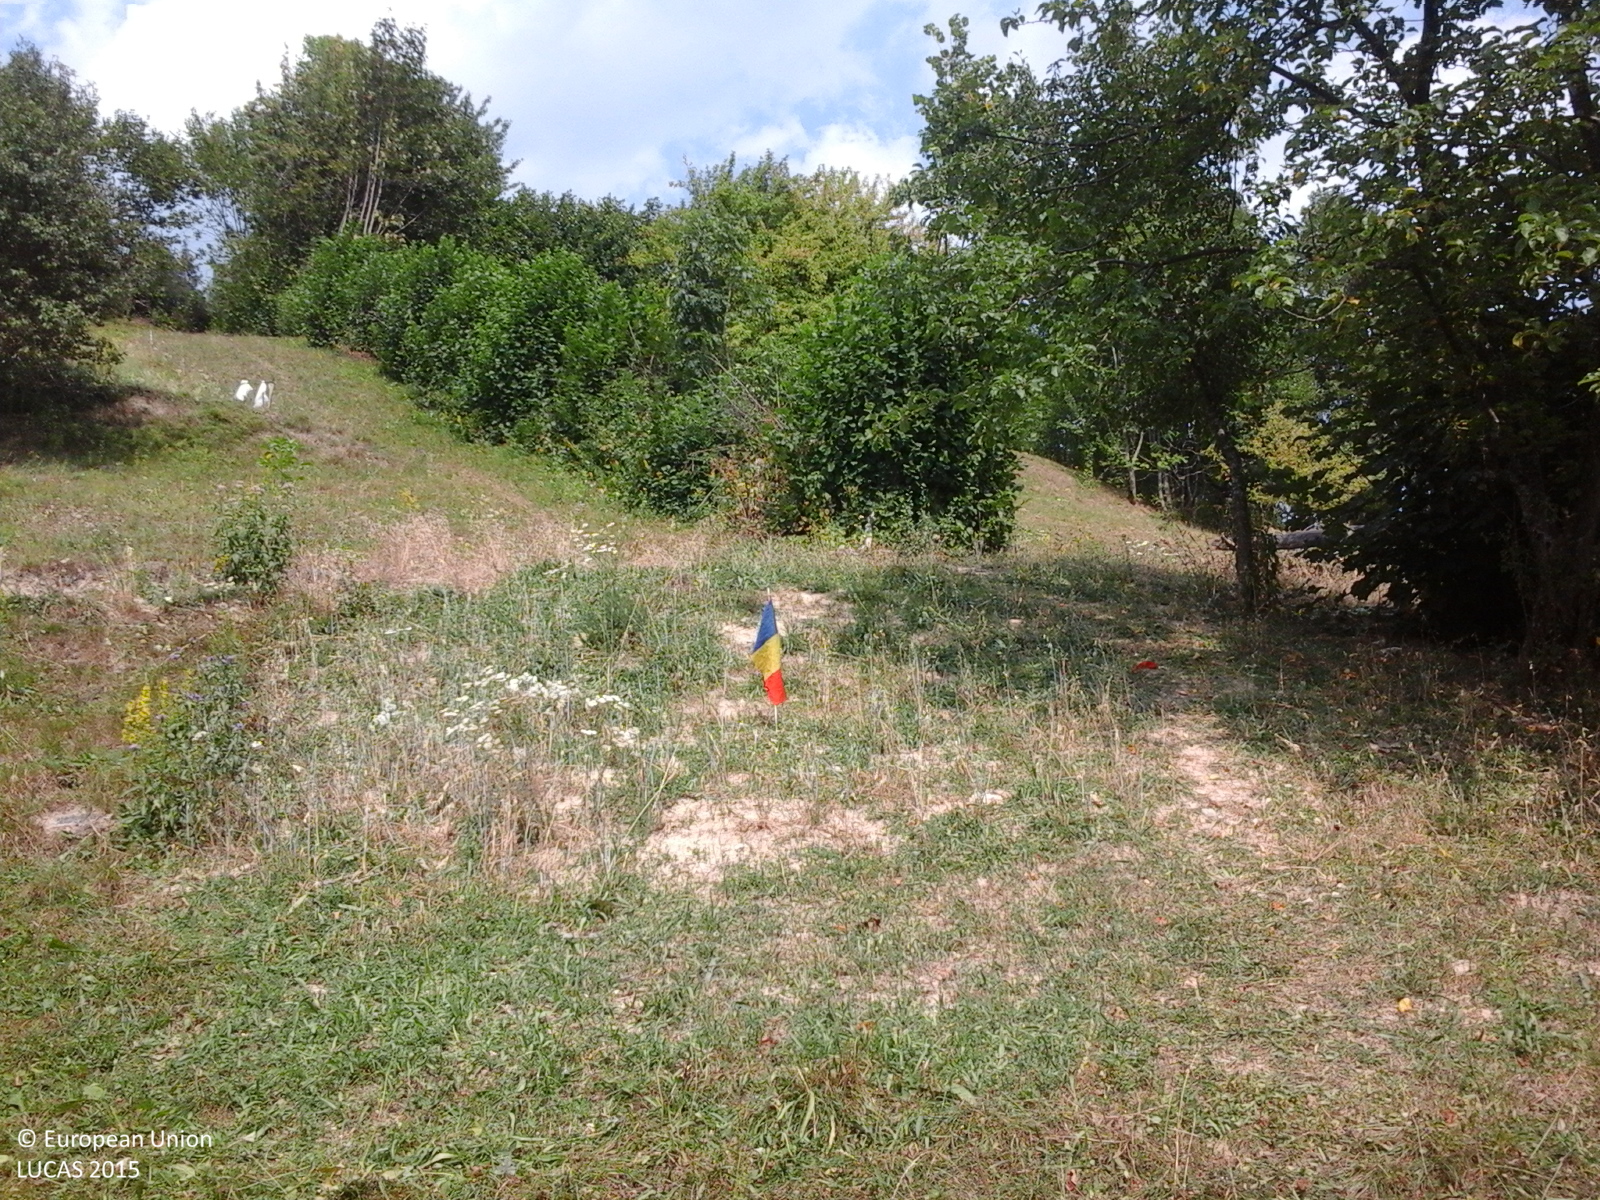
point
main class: Cropland
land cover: Apple fruit
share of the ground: 10 - 25 %
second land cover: Grassland without tree/shrub cover
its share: > 75 %
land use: Agriculture (excluding fallow land and kitchen gardens)
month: September
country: RO
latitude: 47.8521
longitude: 24.4344
